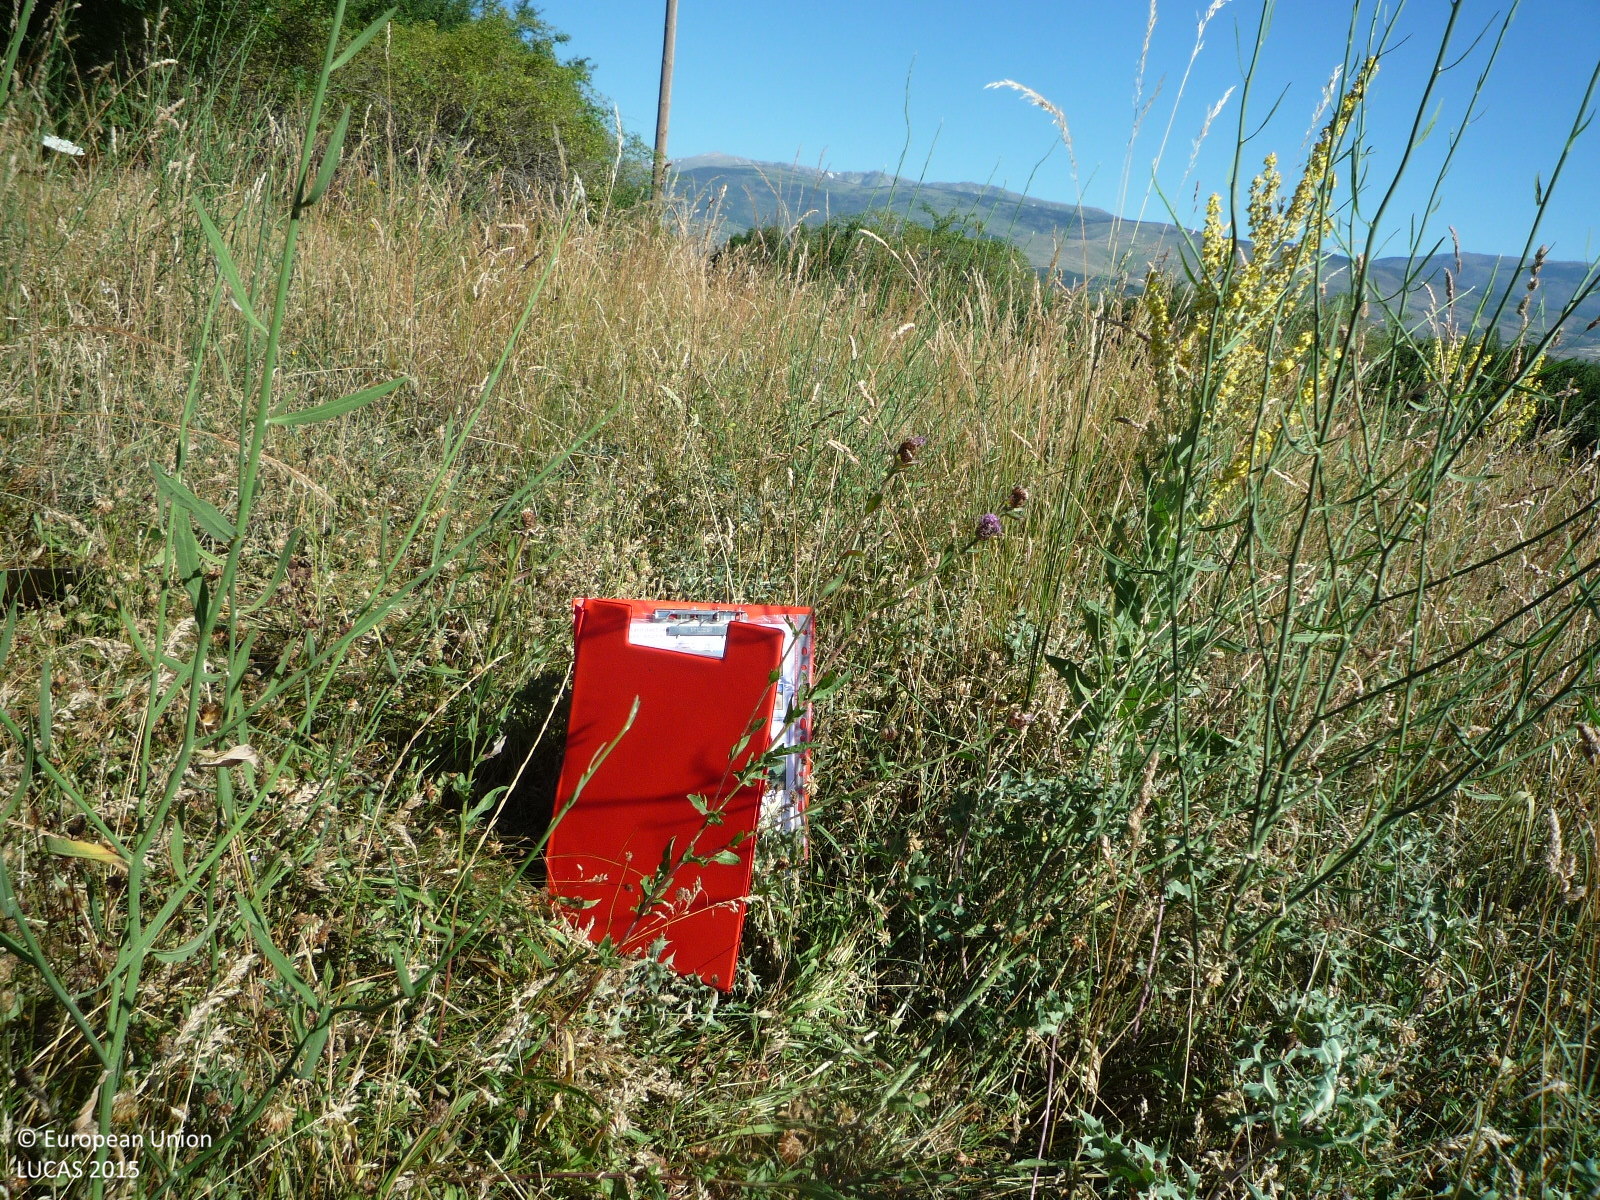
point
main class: Grassland
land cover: Spontaneously vegetated surfaces
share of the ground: > 75 %
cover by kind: herbaceous plants 100 %
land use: Fallow land
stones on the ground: 10 - 25 %
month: July
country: ES
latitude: 42.3825
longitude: 1.8857
